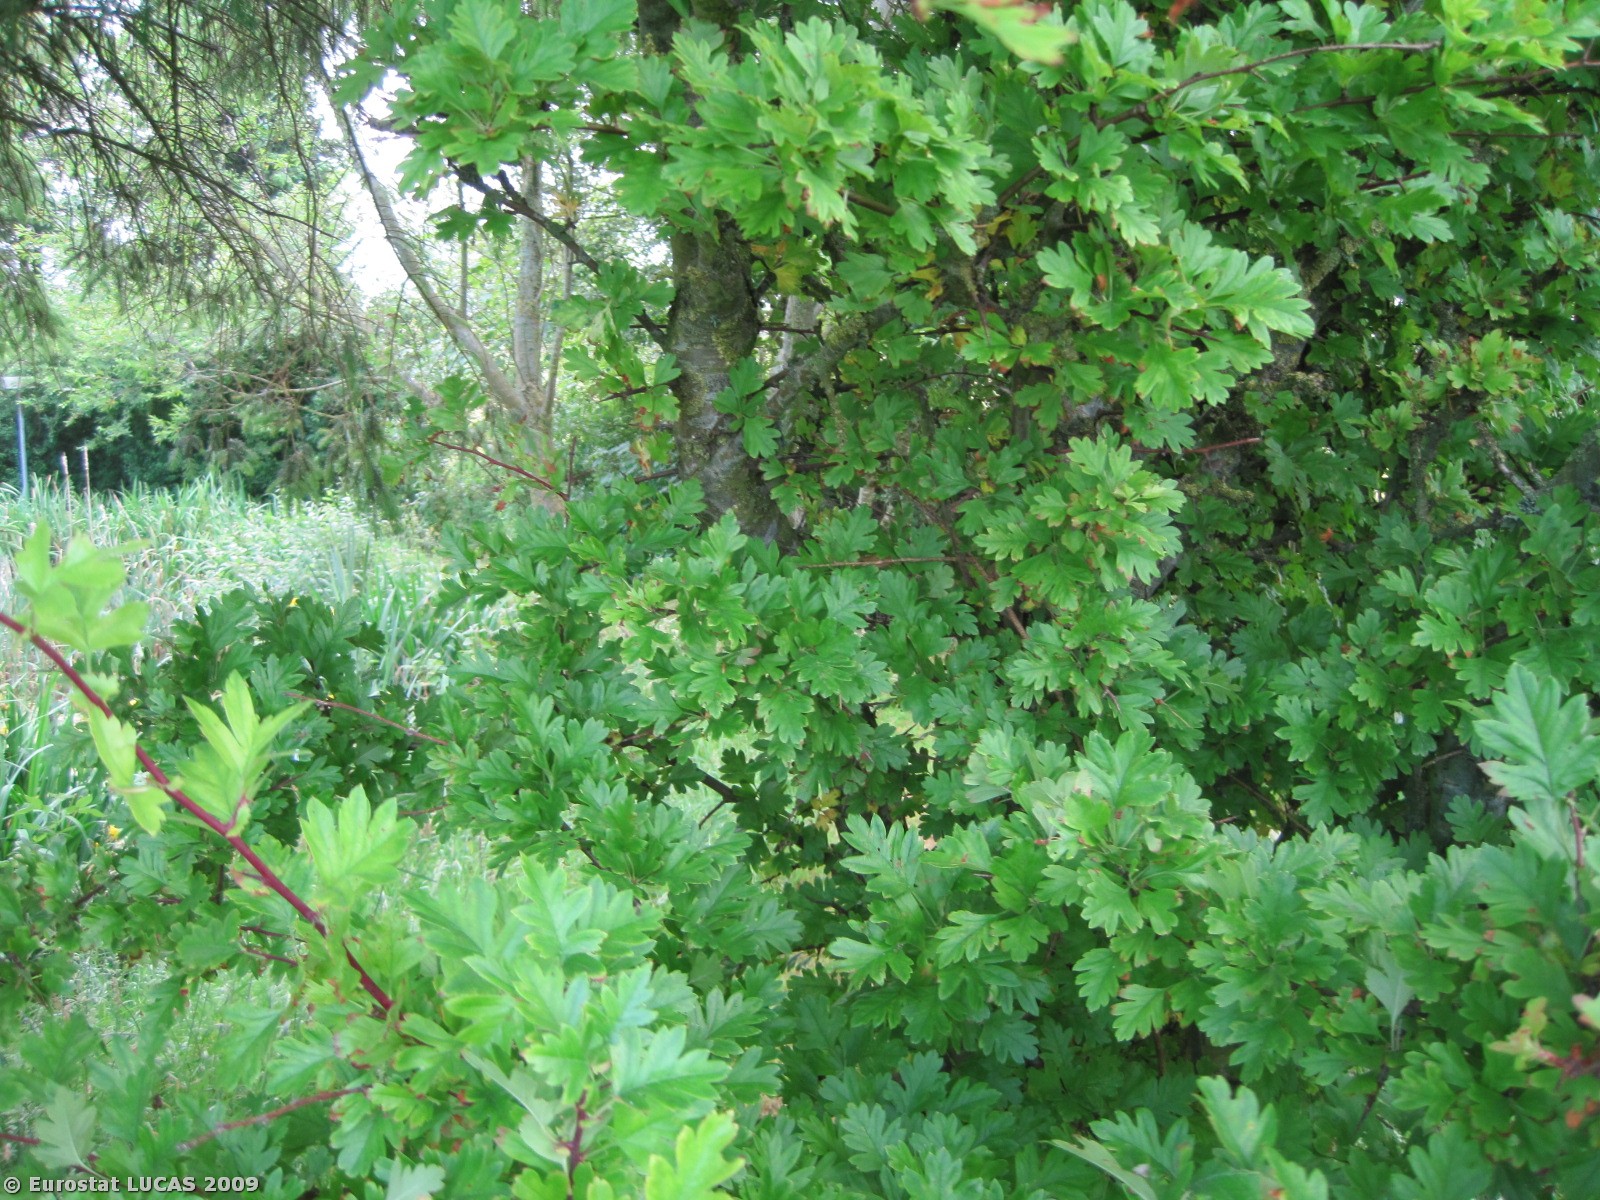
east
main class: Woodland
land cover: Mixed woodland
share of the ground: 50 - 75 %
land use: Residential
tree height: > 5 m
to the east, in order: Mixed woodland; Fences; Grass margins; Barley; Grassland without tree/shrub cover; Common wheat; Grass margins; Tracks; Grass margins; Barley
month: June
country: DK
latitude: 56.5557
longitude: 8.4239
